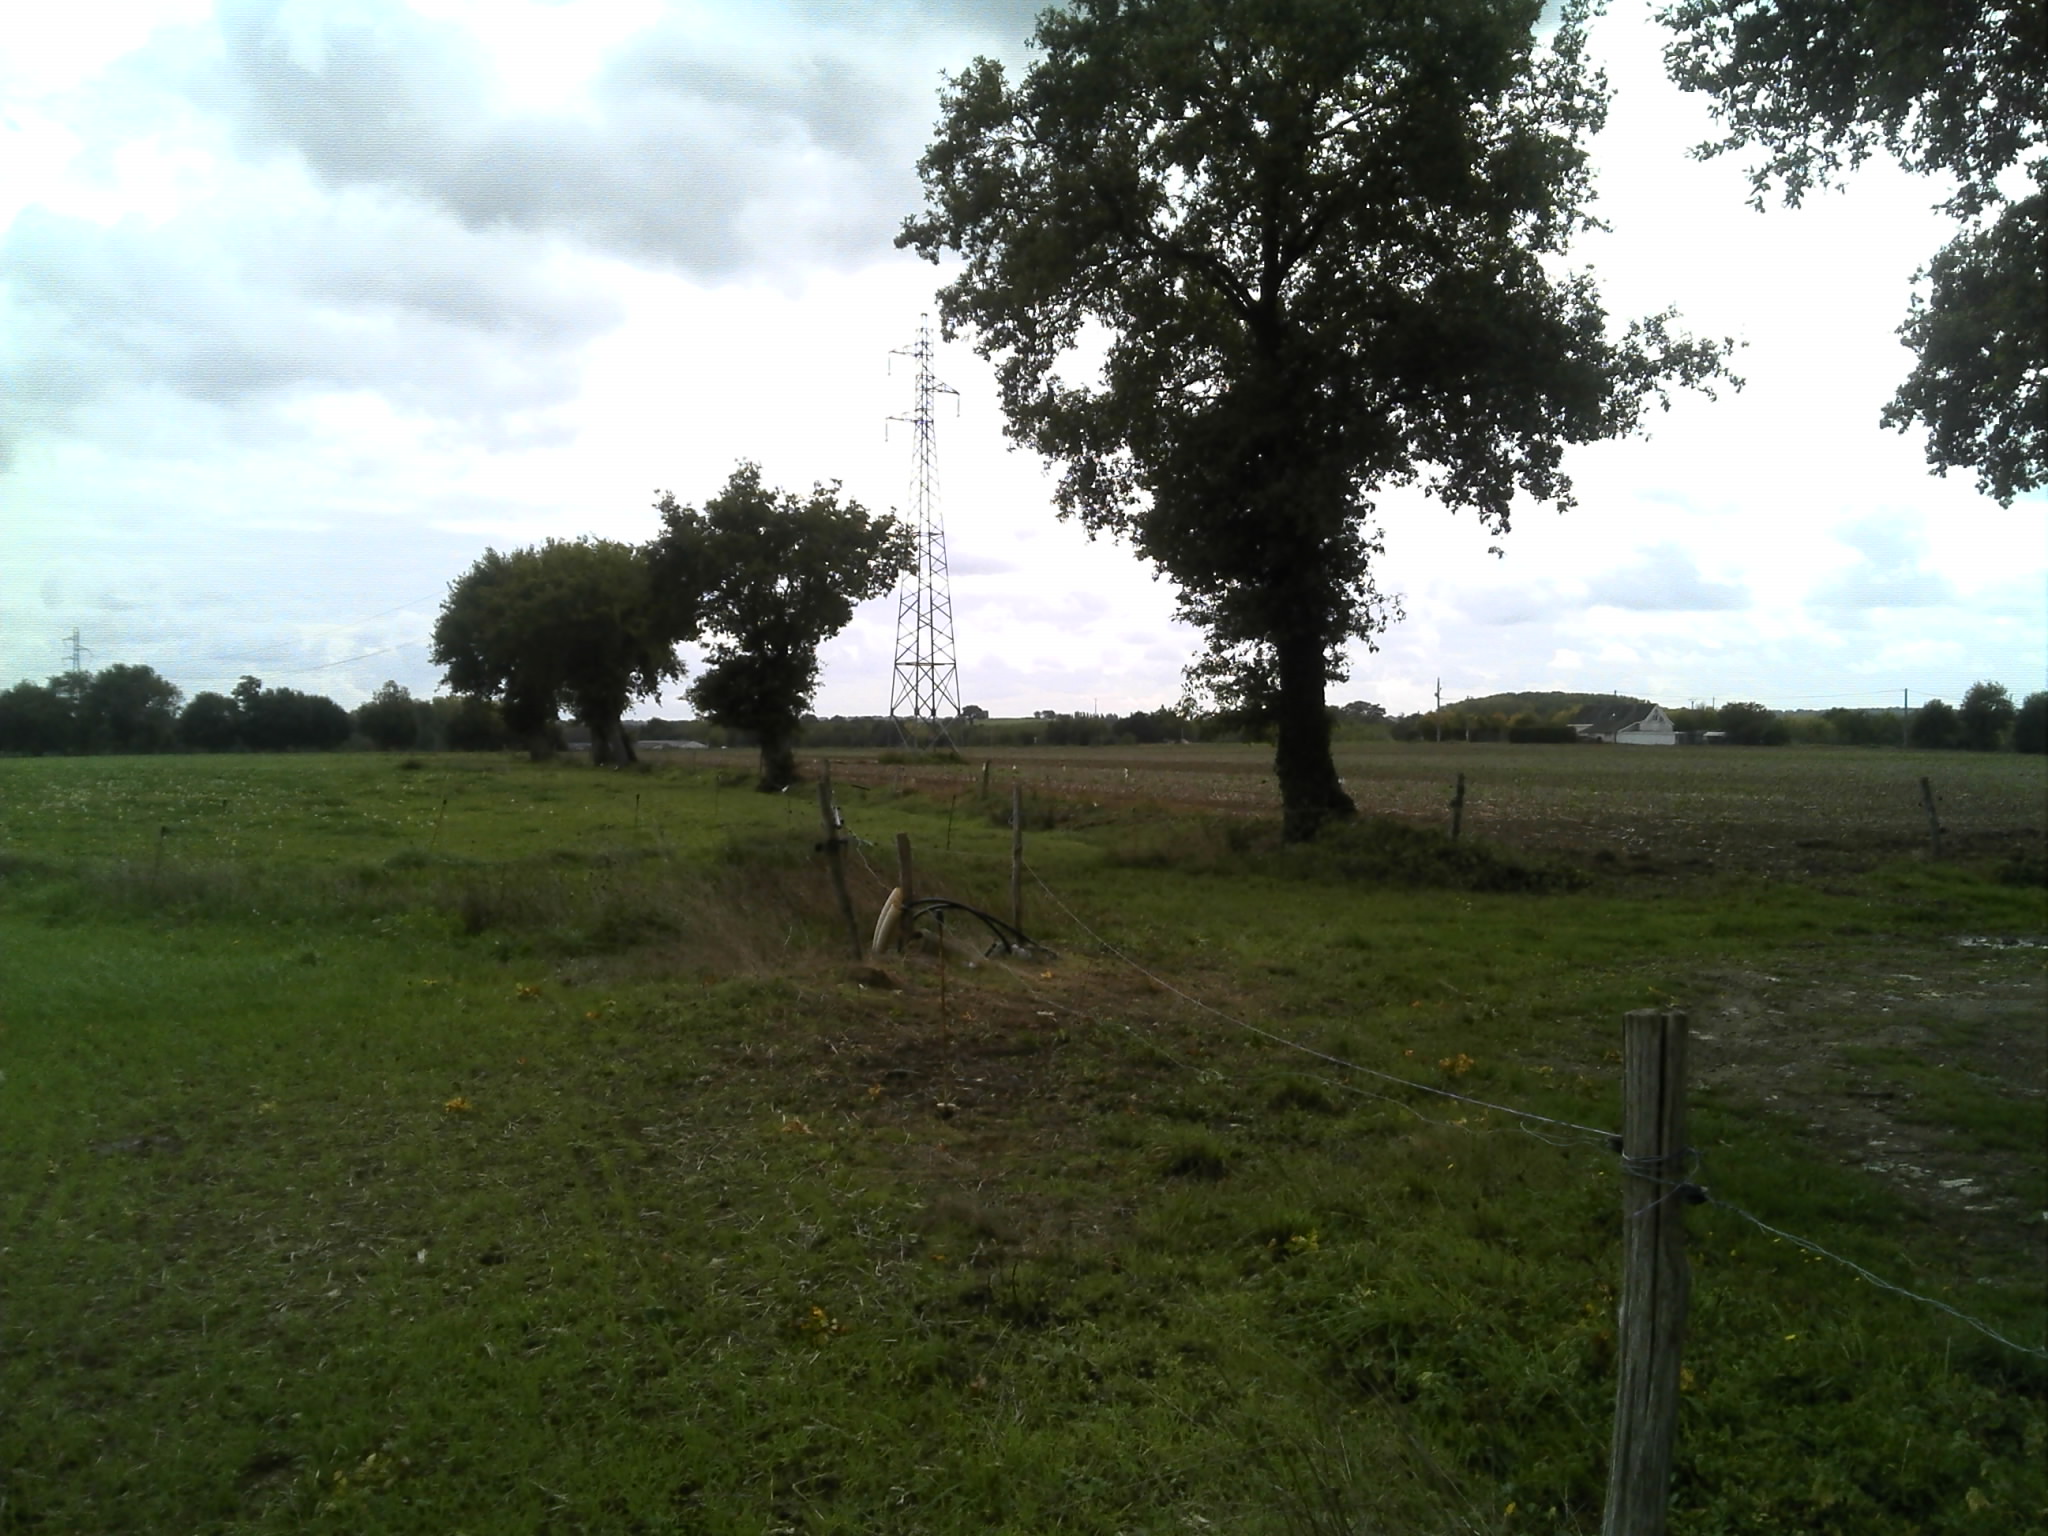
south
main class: Cropland
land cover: Temporary grasslands
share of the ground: > 75 %
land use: Agriculture (excluding fallow land and kitchen gardens)
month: October
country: FR
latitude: 47.6989
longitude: -1.0854
